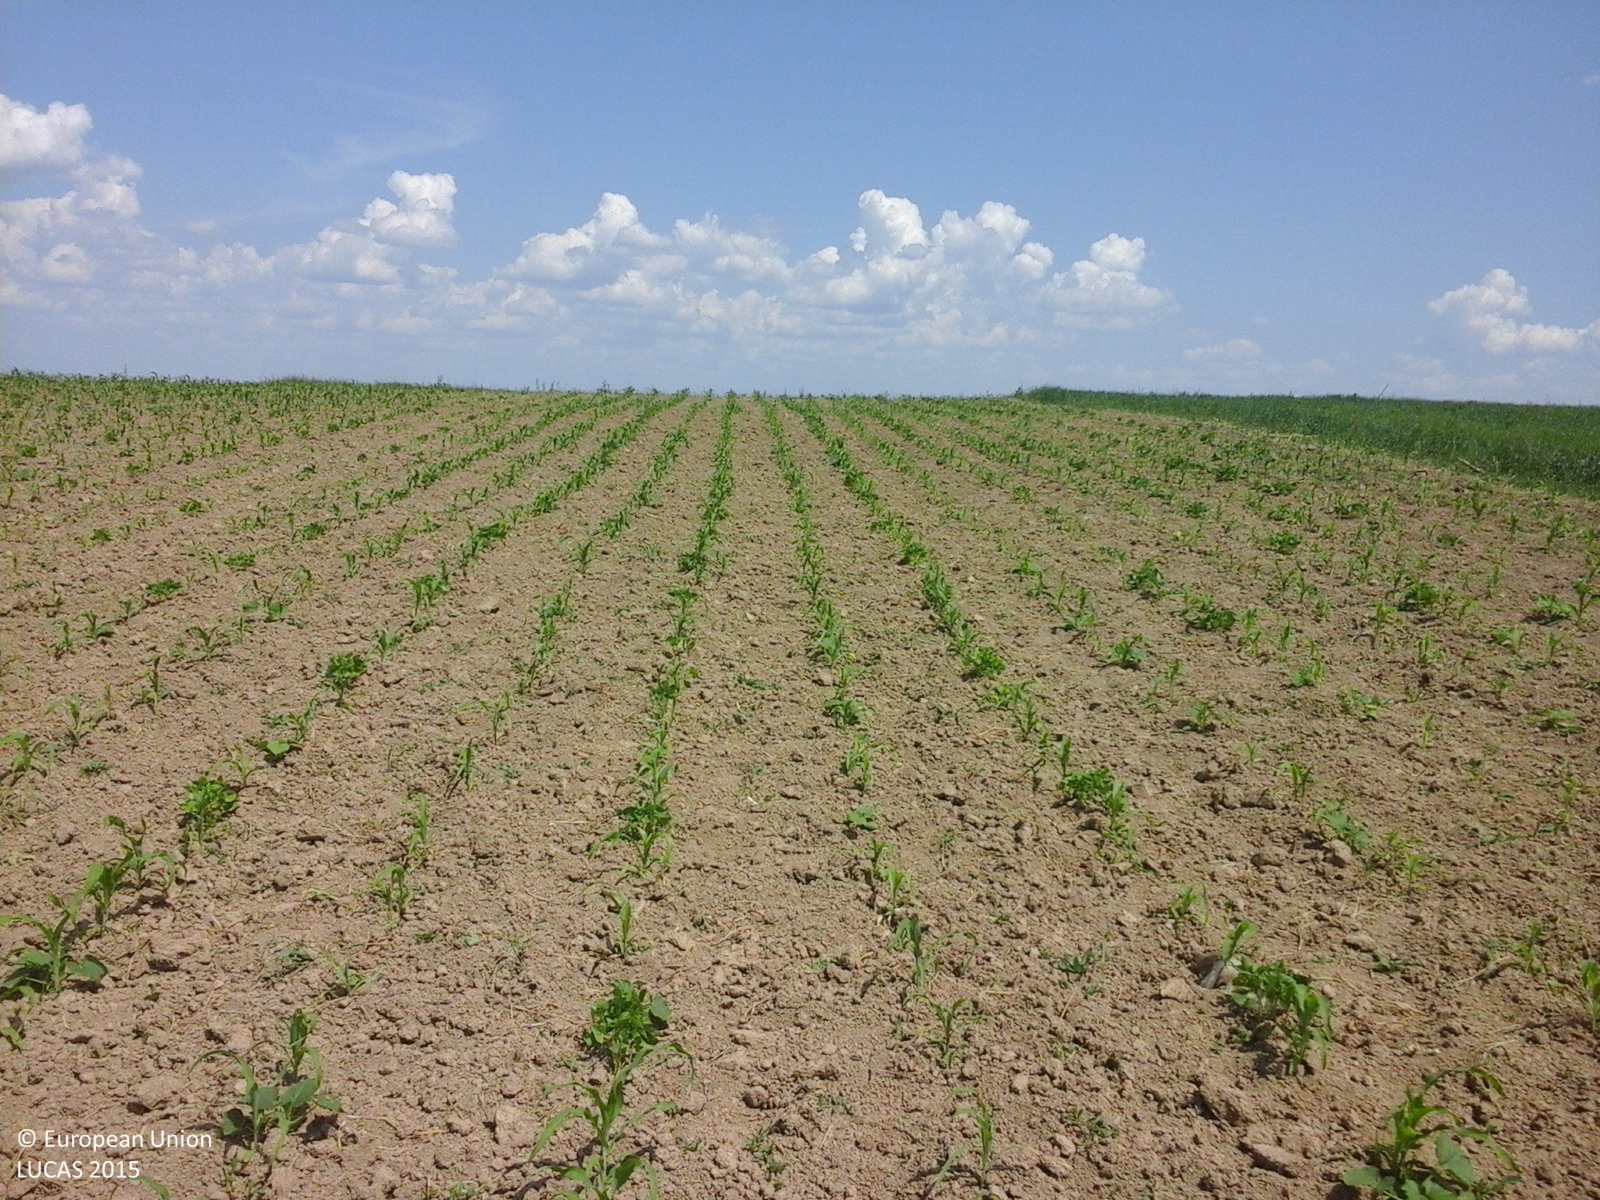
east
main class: Cropland
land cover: Maize
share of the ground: 10 - 25 %
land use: Agriculture (excluding fallow land and kitchen gardens)
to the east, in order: Maize; Tracks; Grassland without tree/shrub cover; Other bare soil; Grassland without tree/shrub cover; Other bare soil; Grassland without tree/shrub cover; Broadleaved woodland; Grassland without tree/shrub cover
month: June
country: RO
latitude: 46.3768
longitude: 26.8757
